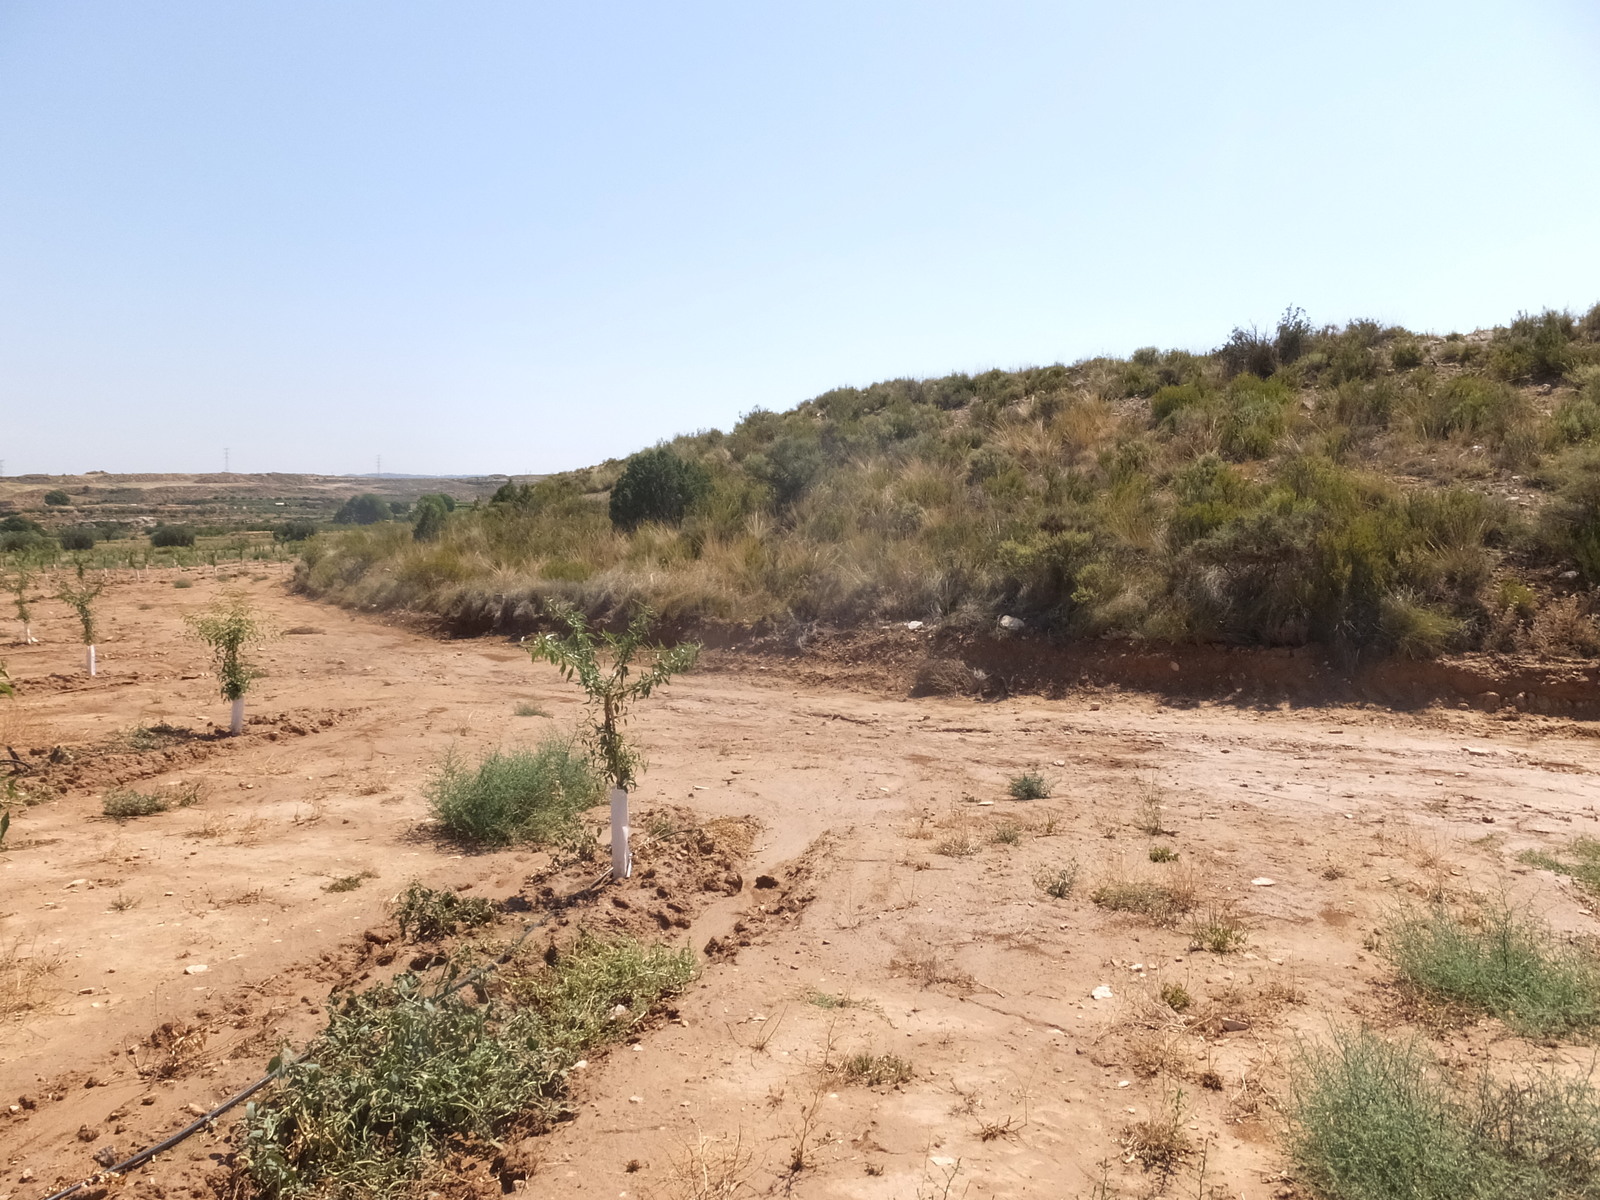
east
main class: Cropland
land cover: Nuts trees
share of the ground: 10 - 25 %
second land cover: Spontaneously vegetated surfaces
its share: < 10 %
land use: Agriculture (excluding fallow land and kitchen gardens)
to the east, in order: Nuts trees; Spontaneously vegetated surfaces; Shrubland without tree cover; Barley; Shrubland without tree cover
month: July
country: ES
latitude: 41.1898
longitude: -0.0391
